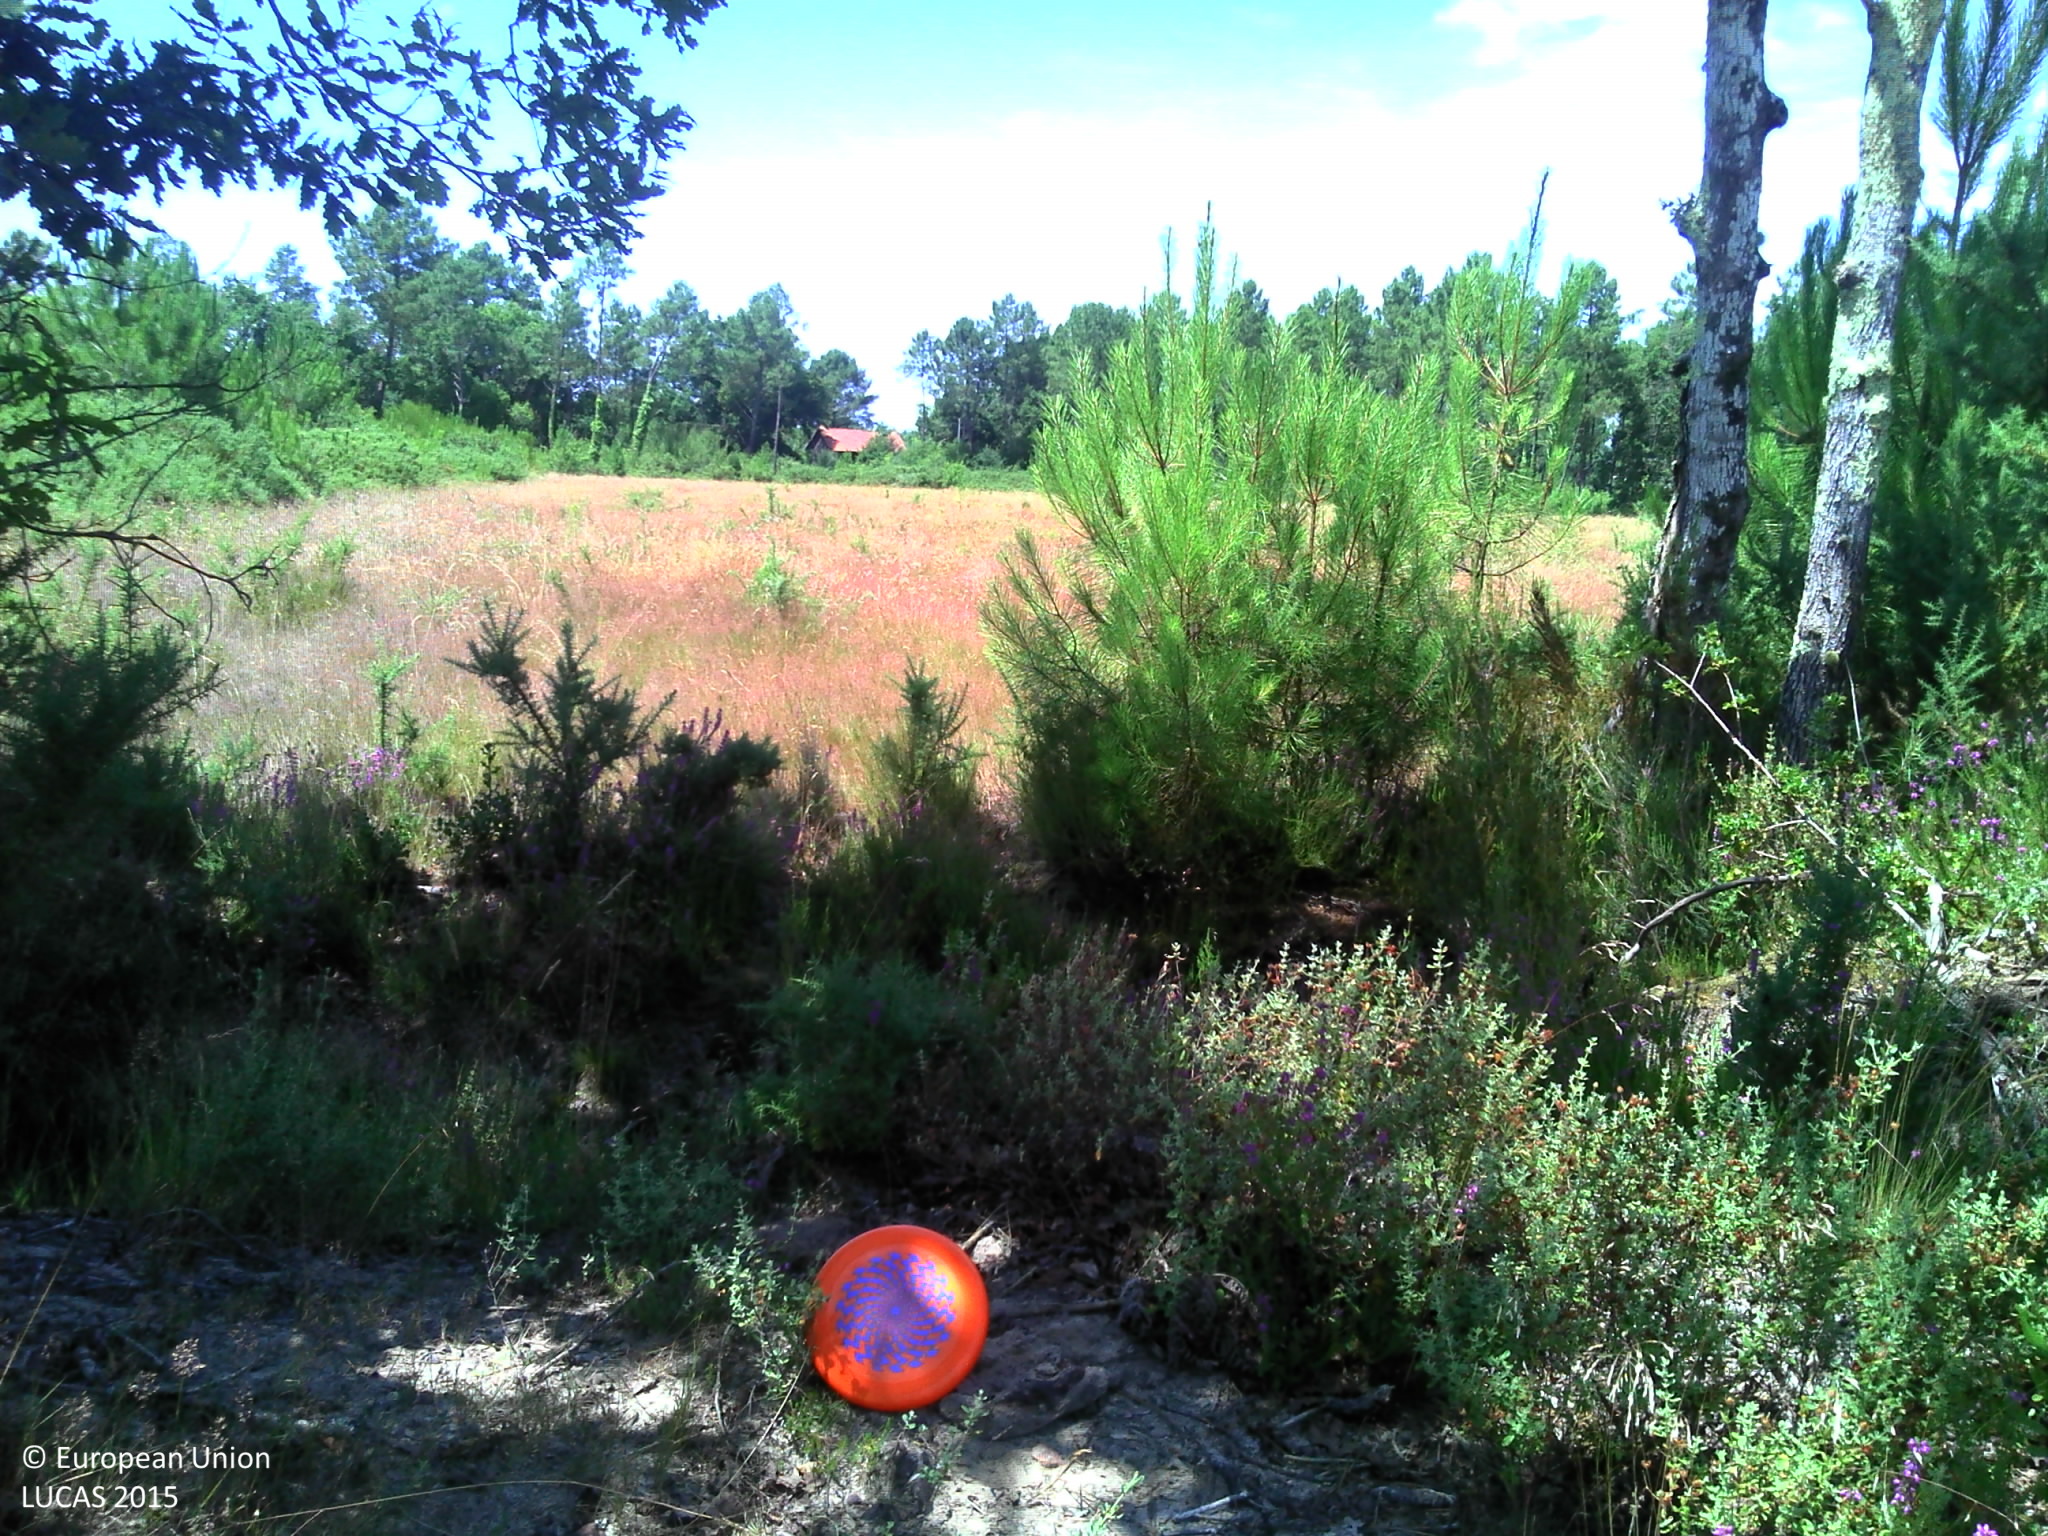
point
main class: Woodland
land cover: Pine dominated mixed woodland
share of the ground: > 75 %
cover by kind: coniferous forest trees 40 %, broadleaved forest trees 40 %, shrubs 10 %, herbaceous plants 10 %
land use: Forestry
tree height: > 5 m
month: July
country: FR
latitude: 43.9787
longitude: -1.2014
